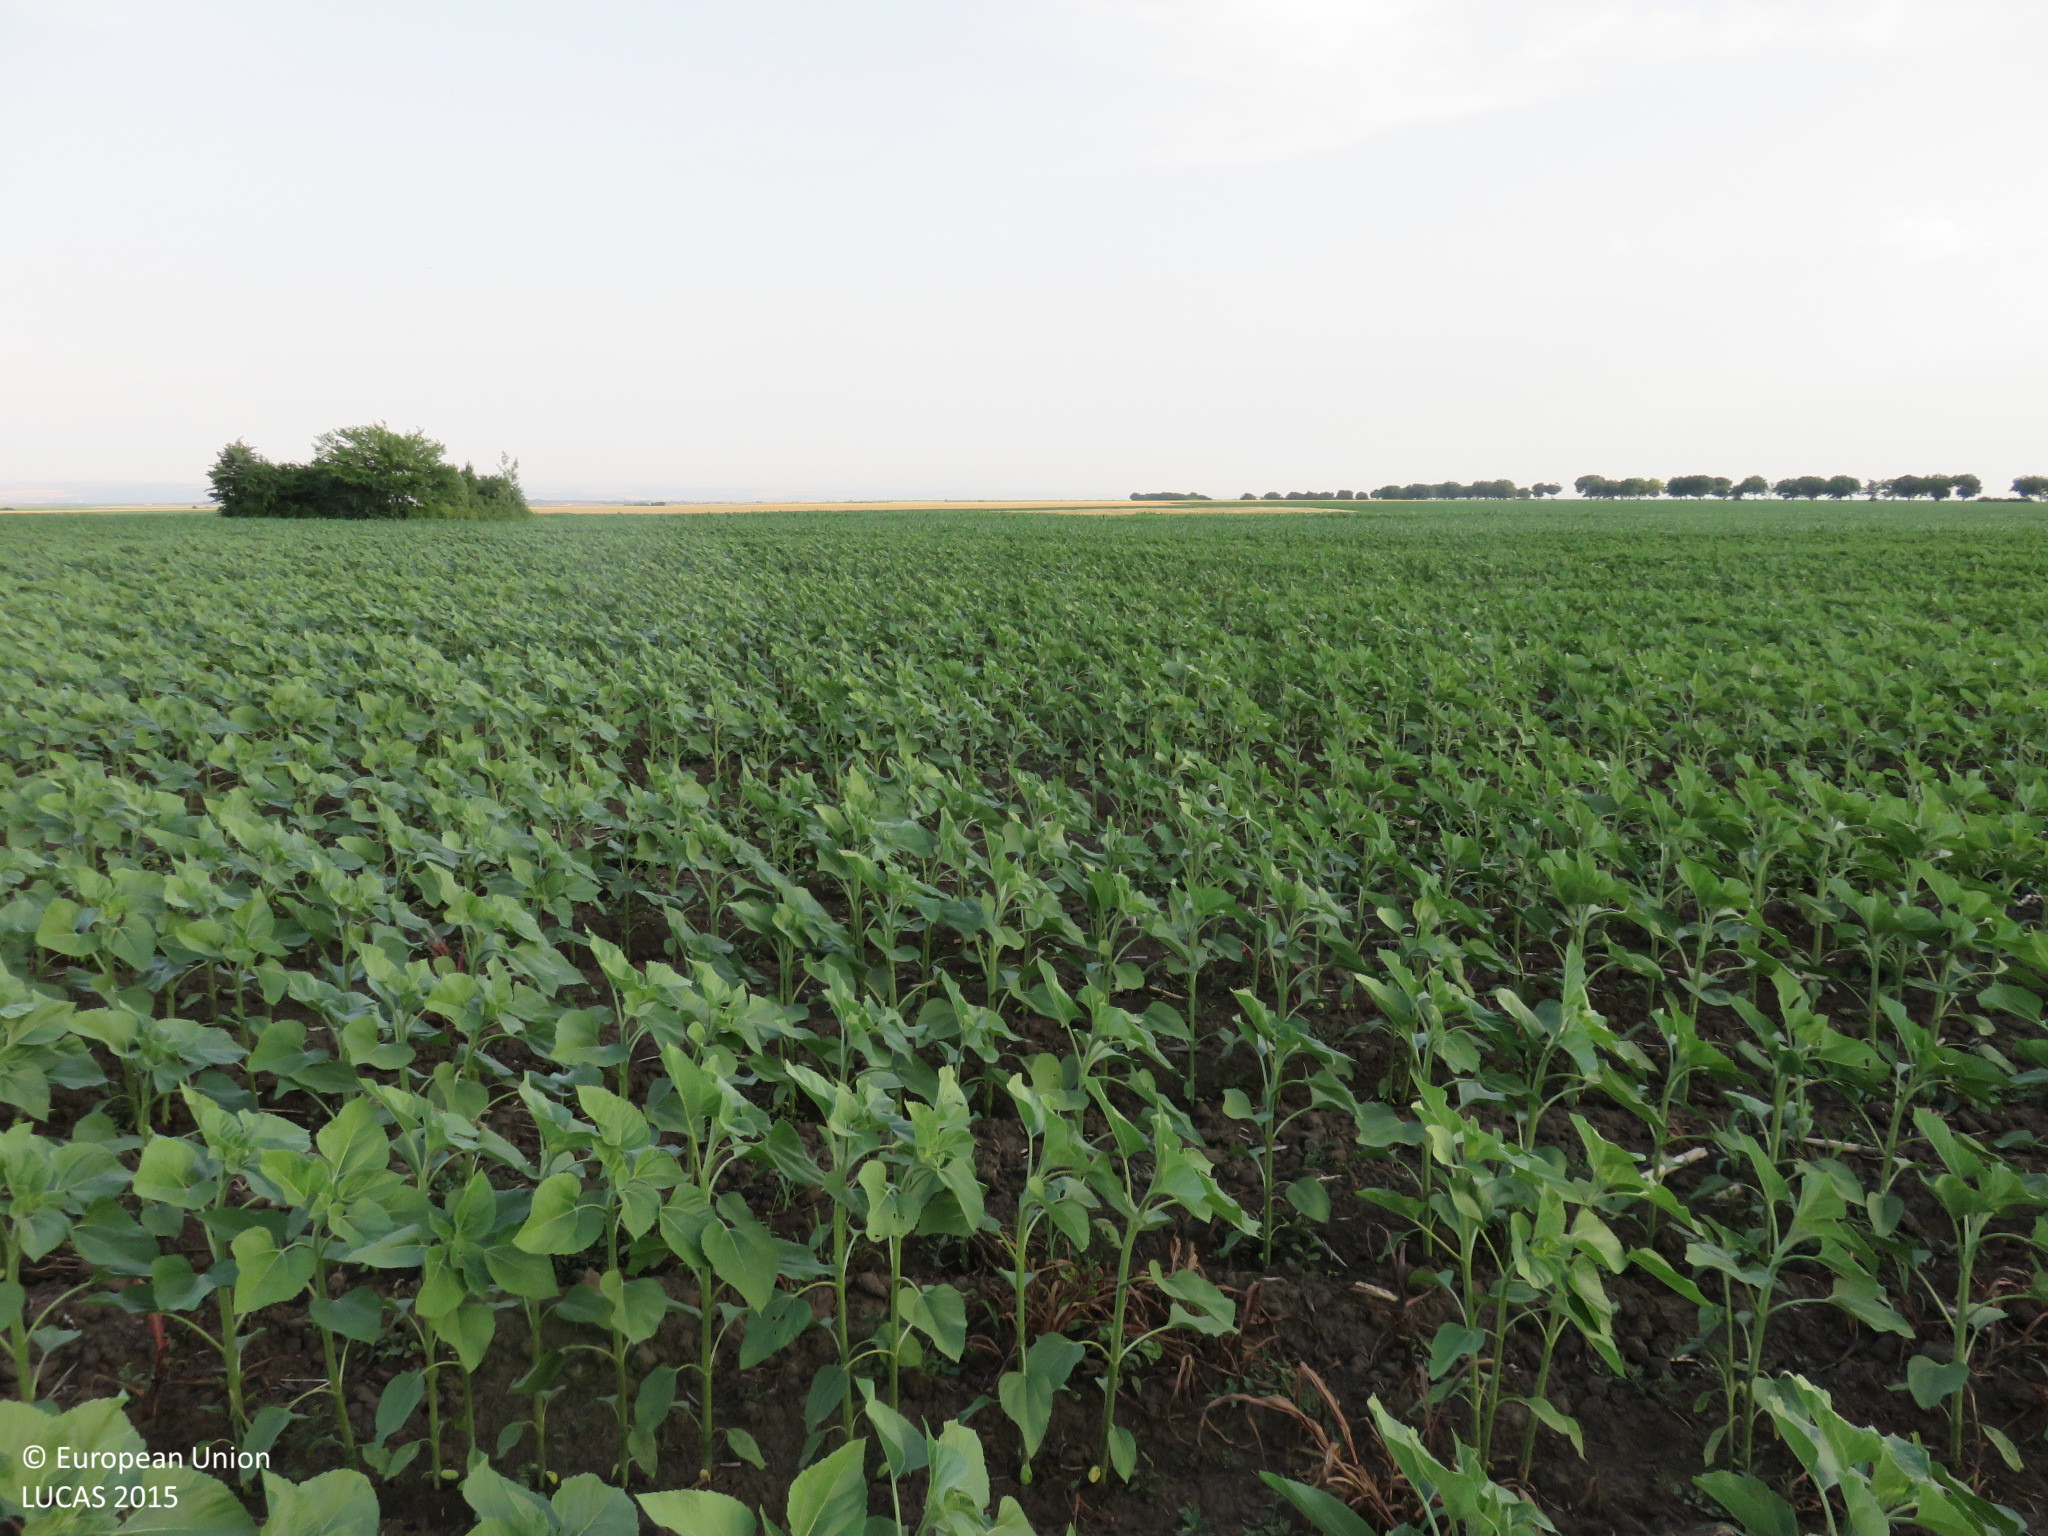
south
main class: Cropland
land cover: Sunflower
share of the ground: > 75 %
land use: Agriculture (excluding fallow land and kitchen gardens)
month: June
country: BG
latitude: 43.5692
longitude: 24.4614
